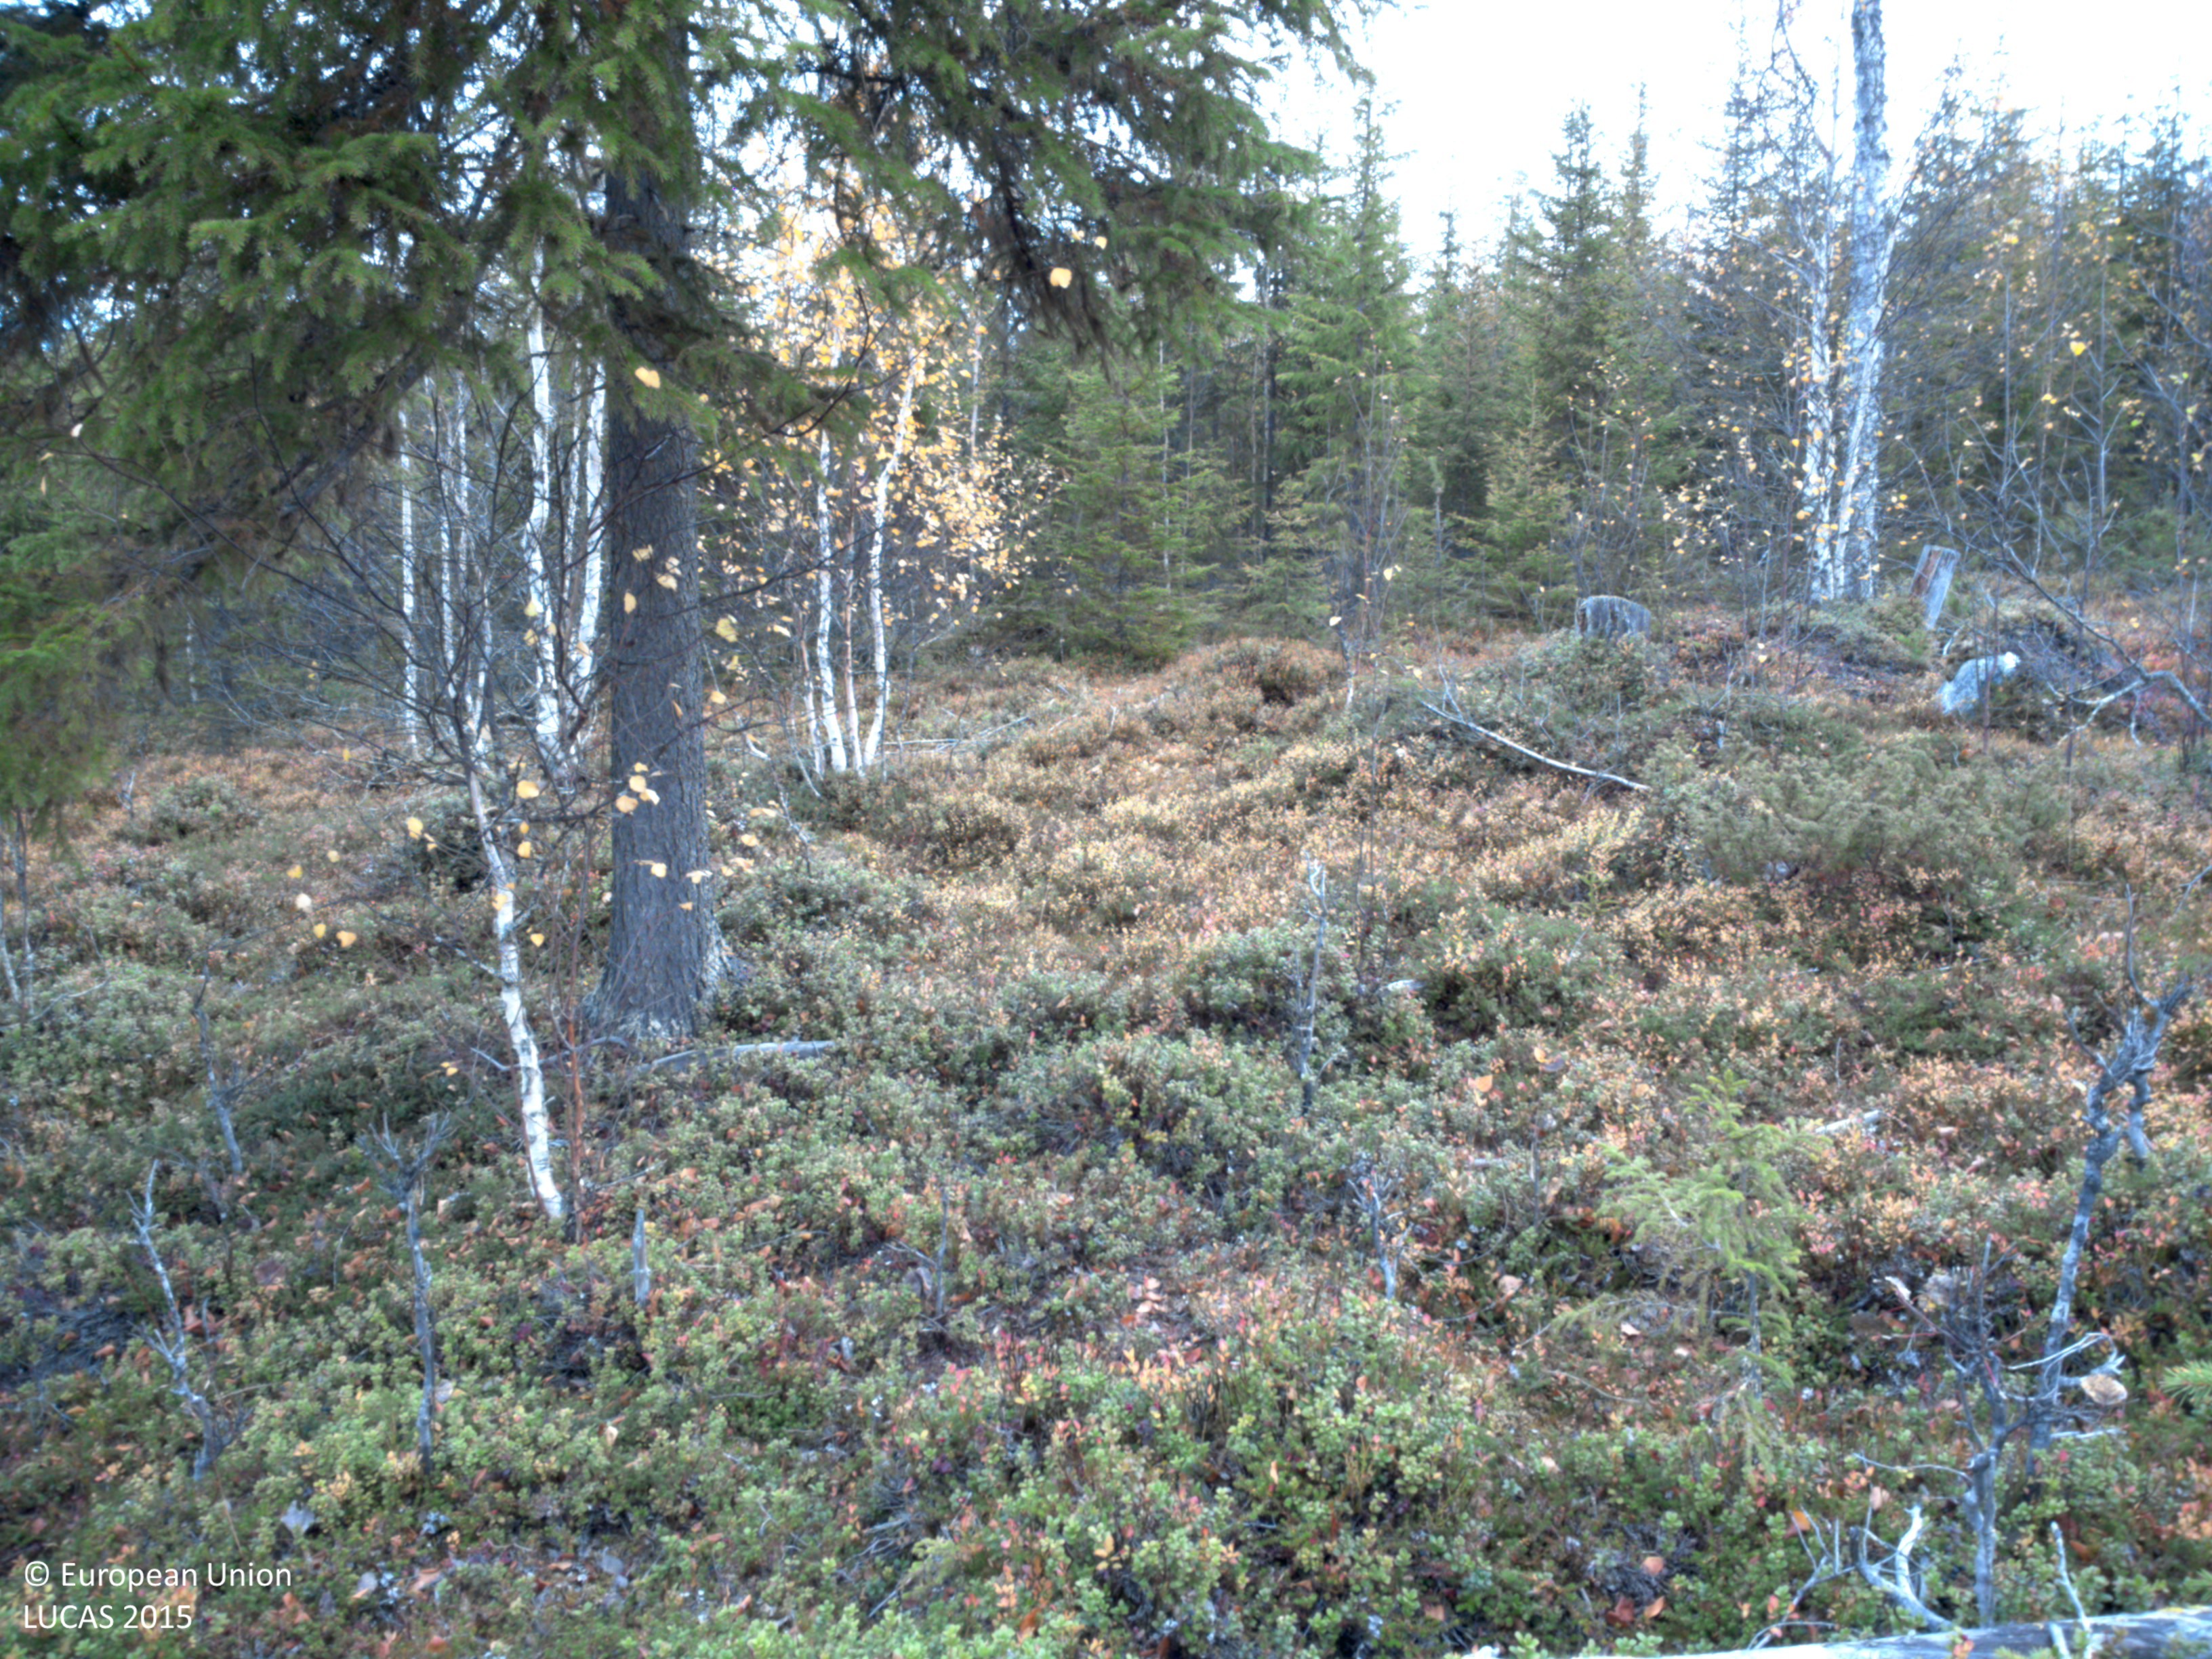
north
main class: Woodland
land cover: Spruce dominated mixed woodland
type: boreal forest
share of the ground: 25 - 50 %
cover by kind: shrubs 50 %, coniferous forest trees 30 %, broadleaved forest trees 10 %, herbaceous plants 5 %, lichens and mosses 5 %
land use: Forestry
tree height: < 5 m
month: October
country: SE
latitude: 64.6945
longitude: 18.2066
